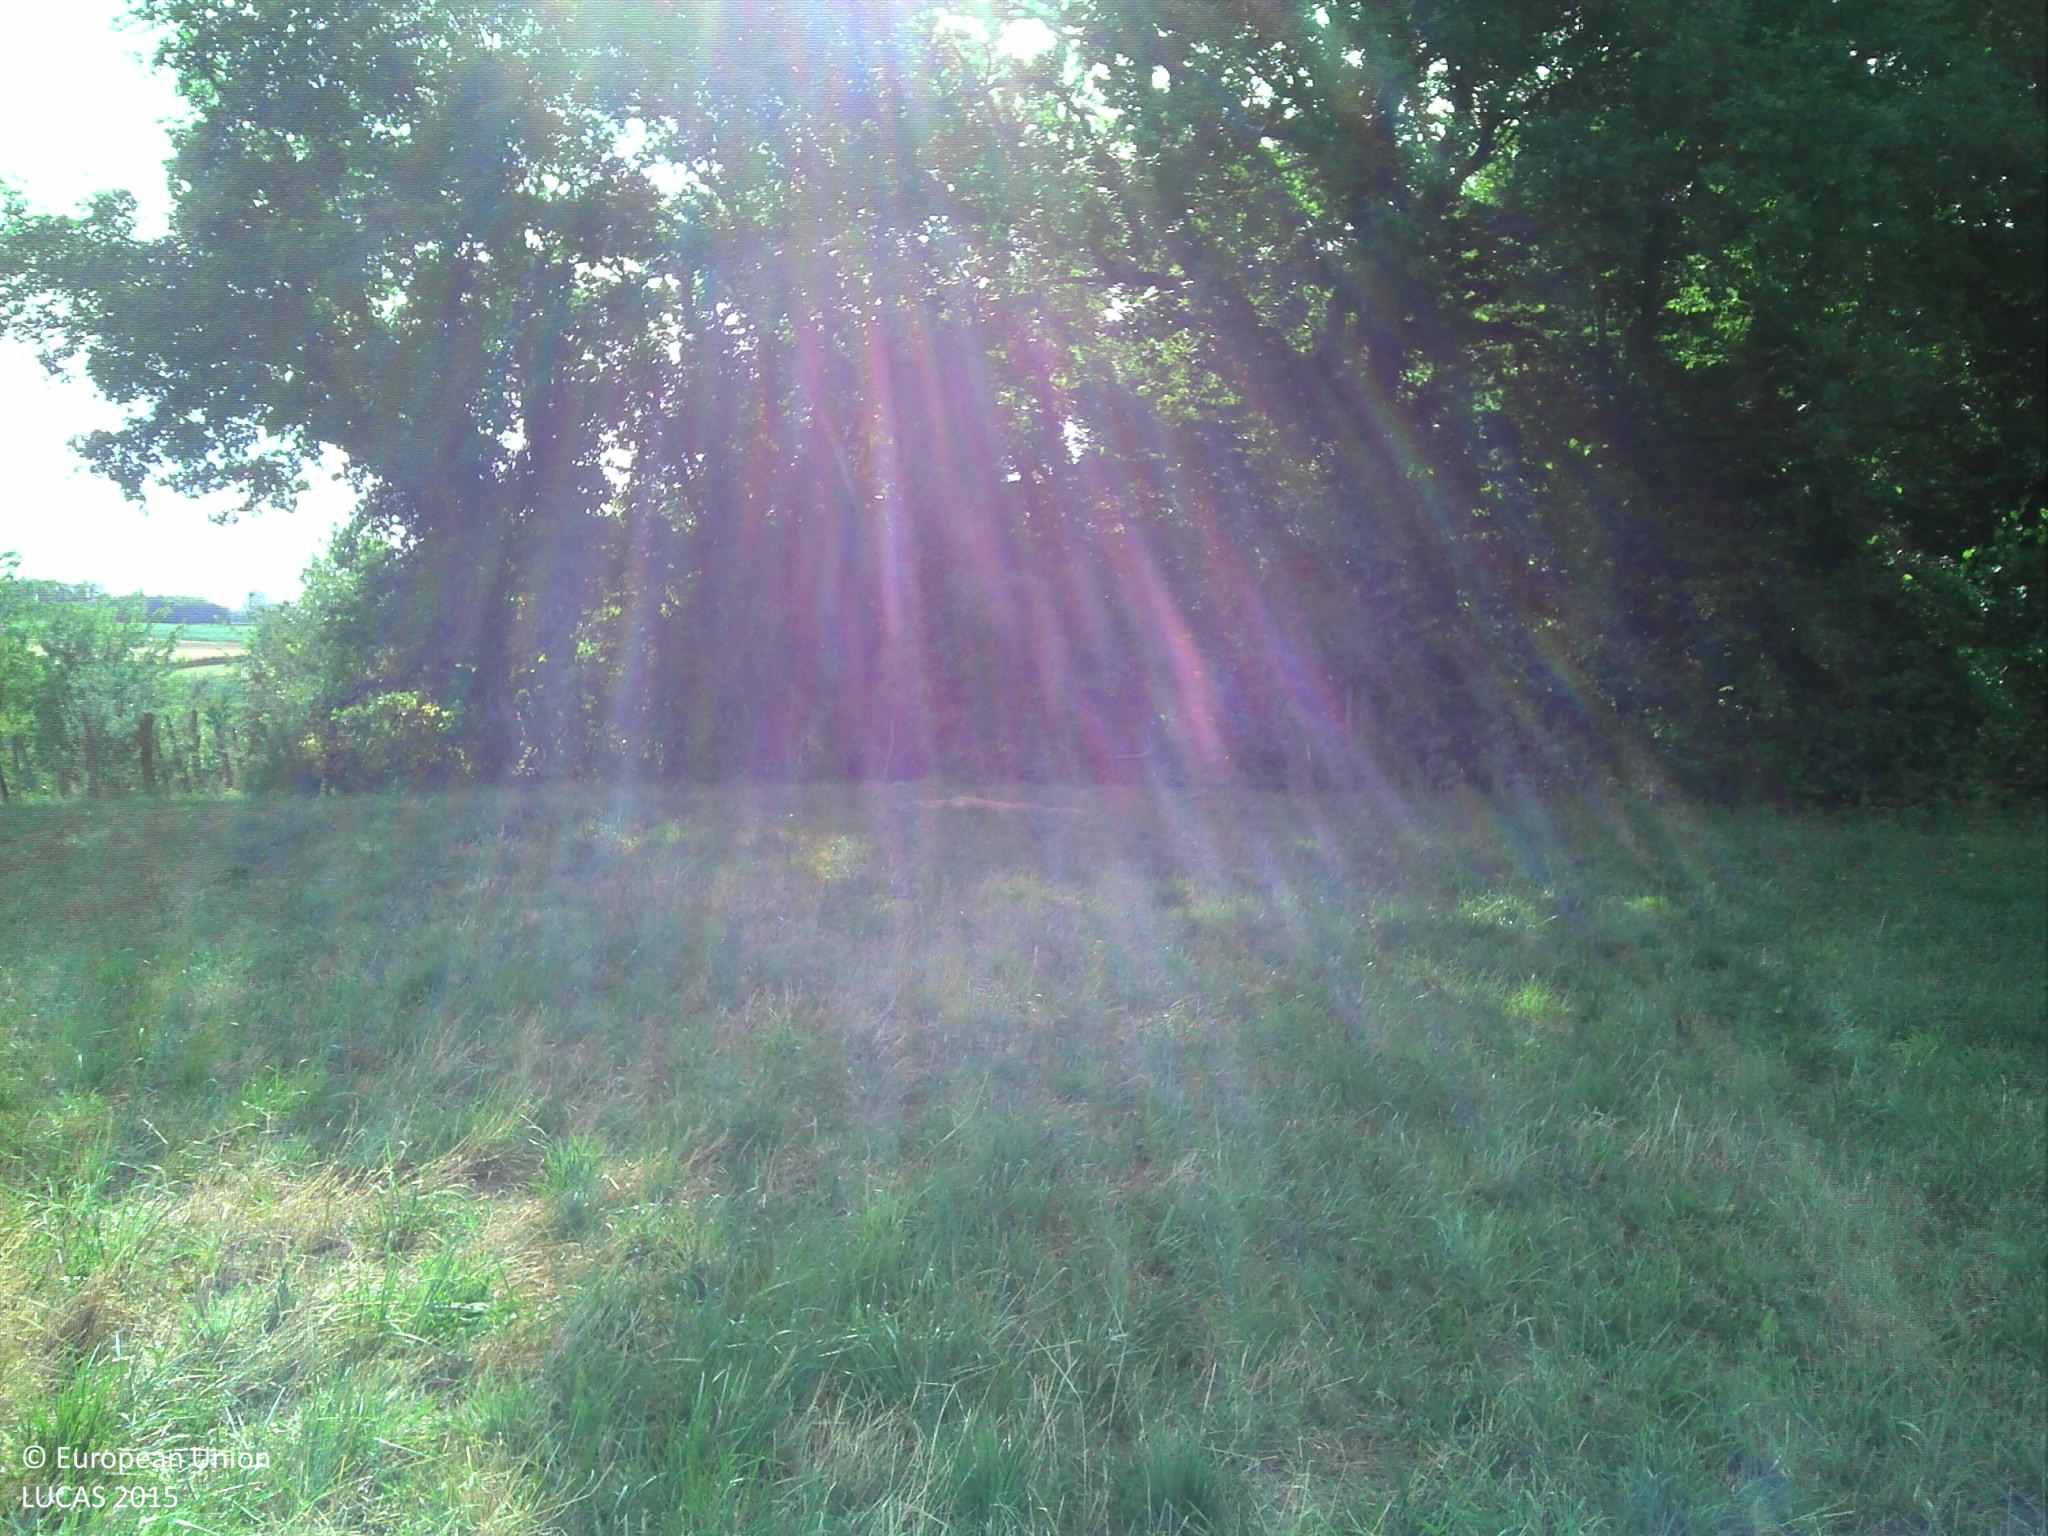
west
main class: Grassland
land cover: Grassland without tree/shrub cover
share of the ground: > 75 %
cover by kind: herbaceous plants 100 %
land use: Agriculture (excluding fallow land and kitchen gardens)
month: July
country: FR
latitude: 45.6028
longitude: 5.4016
